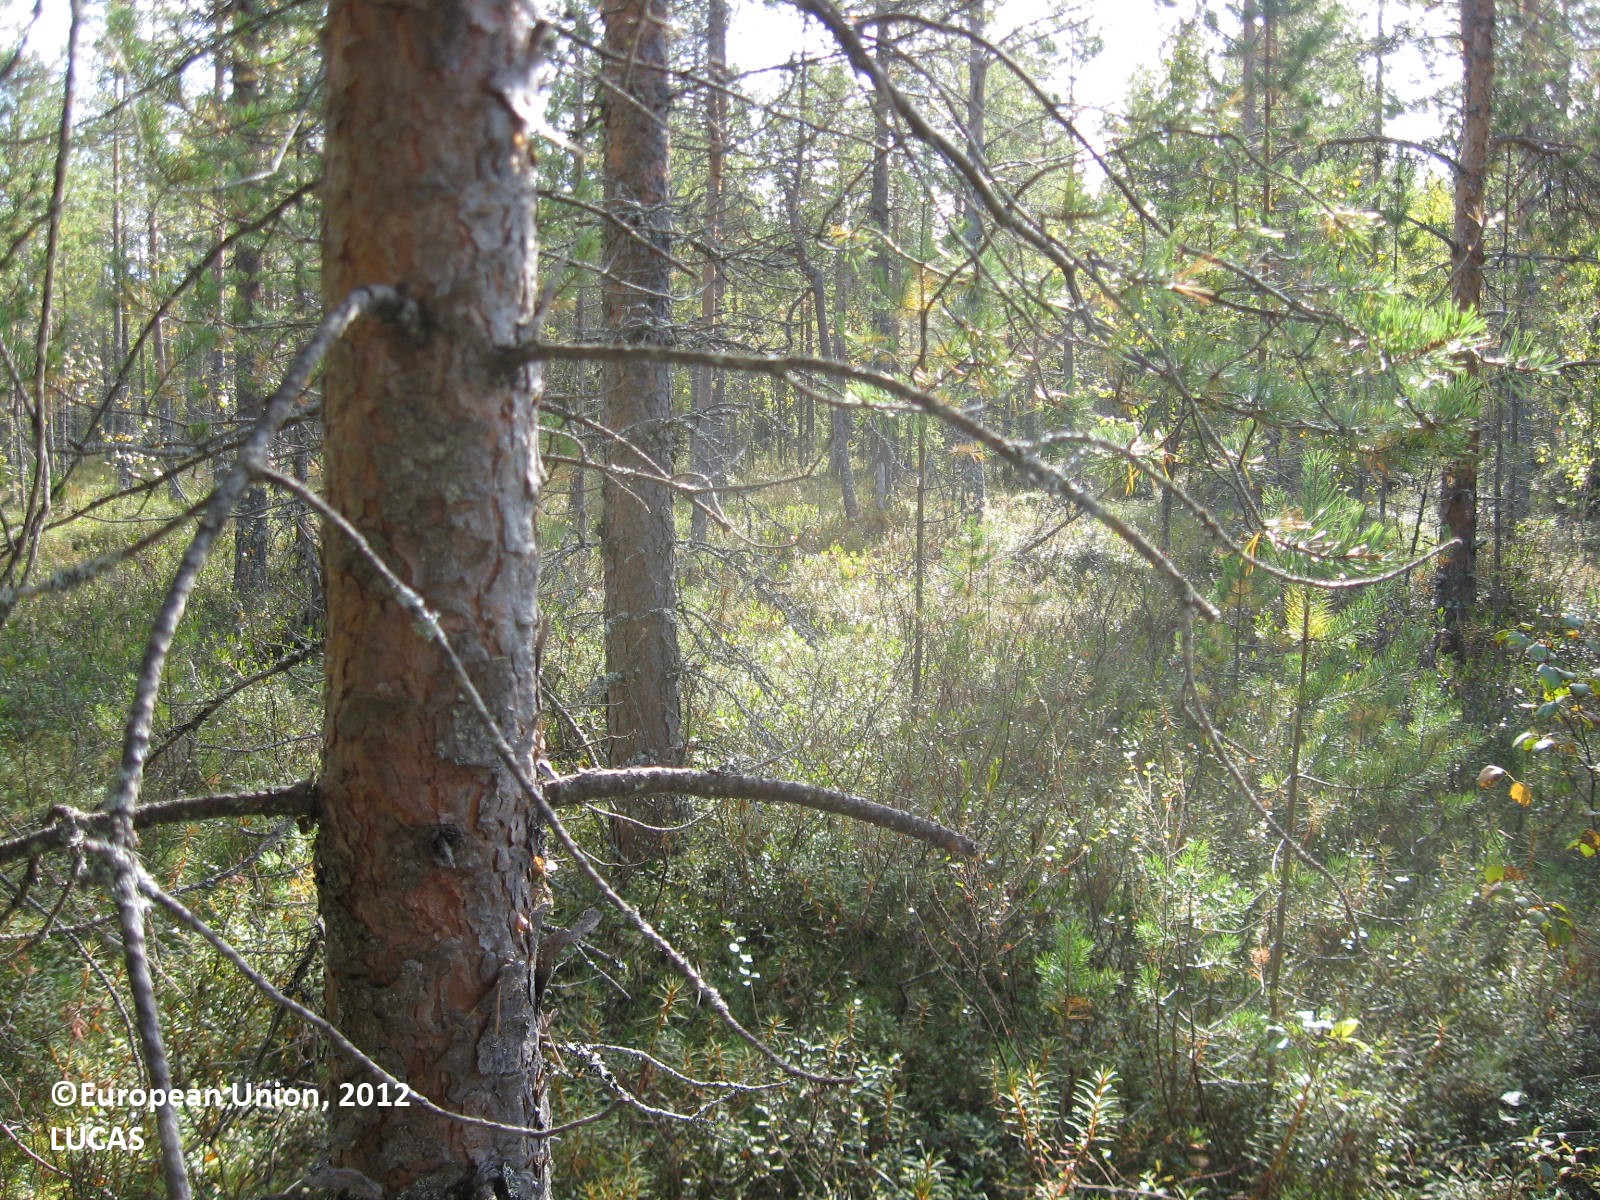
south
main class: Woodland
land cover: Pine dominated mixed woodland
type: boreal forest
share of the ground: > 75 %
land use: Forestry
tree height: > 5 m
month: August
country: FI
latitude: 63.9251
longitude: 28.6854
